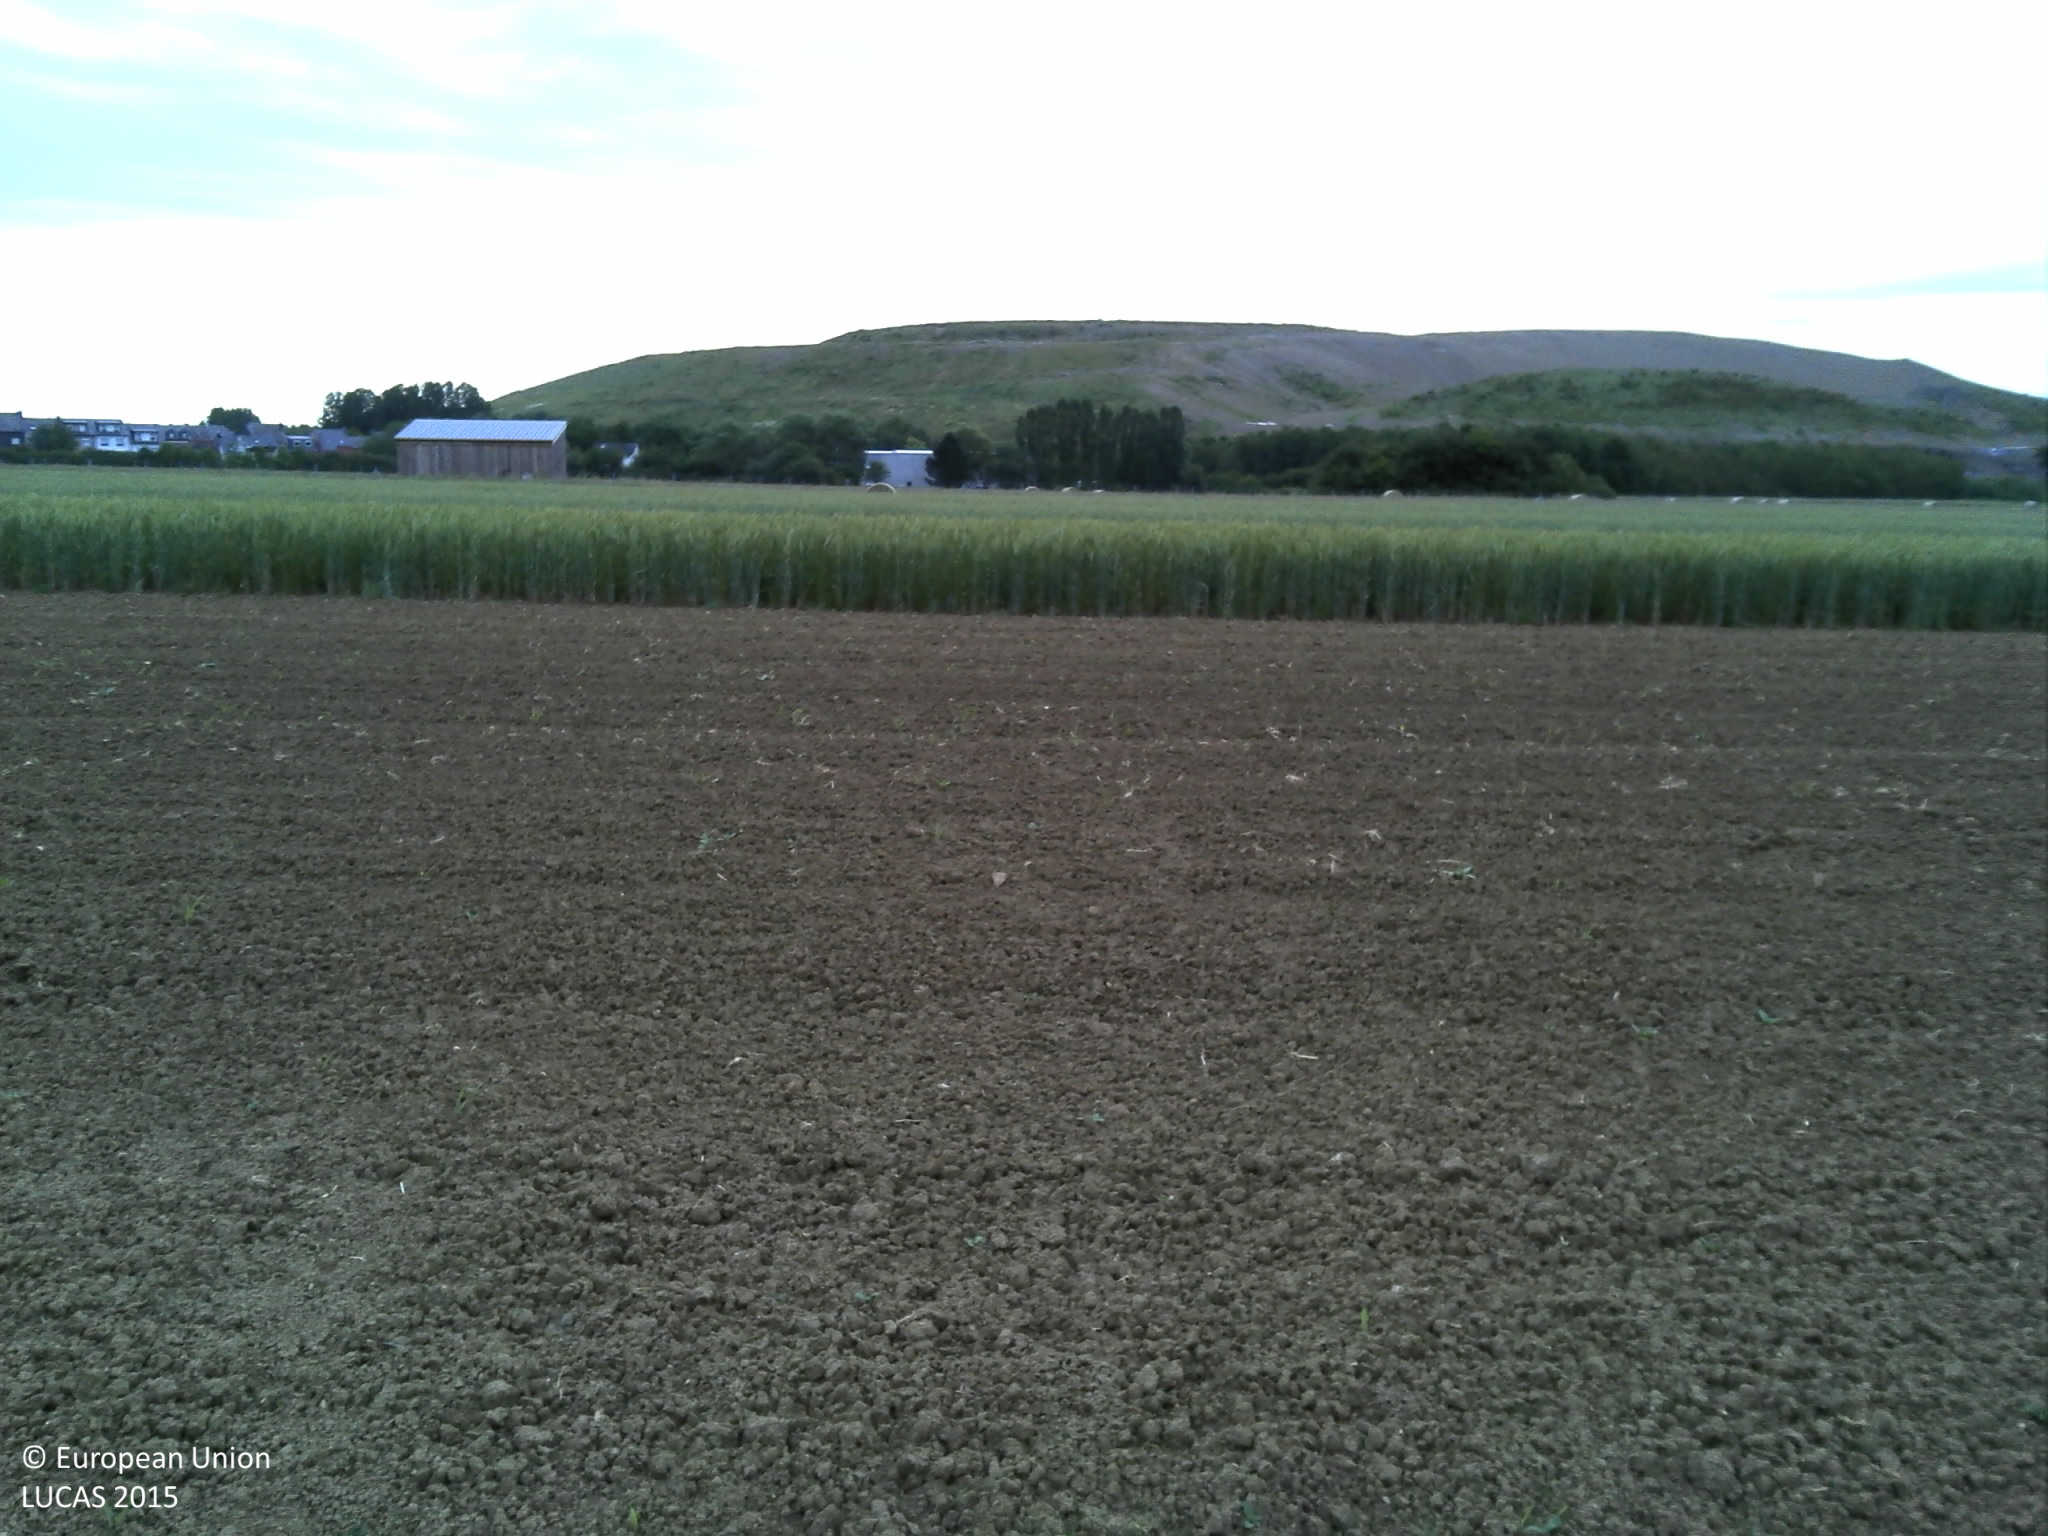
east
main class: Cropland
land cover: Maize
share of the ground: < 10 %
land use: Agriculture (excluding fallow land and kitchen gardens)
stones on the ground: < 10 %
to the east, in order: Maize; Barley; Temporary grasslands; Fences; Grassland without tree/shrub cover; Fences; Temporary grasslands; Grass margins; Maize
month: June
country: LU
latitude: 49.5192
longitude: 5.9796
